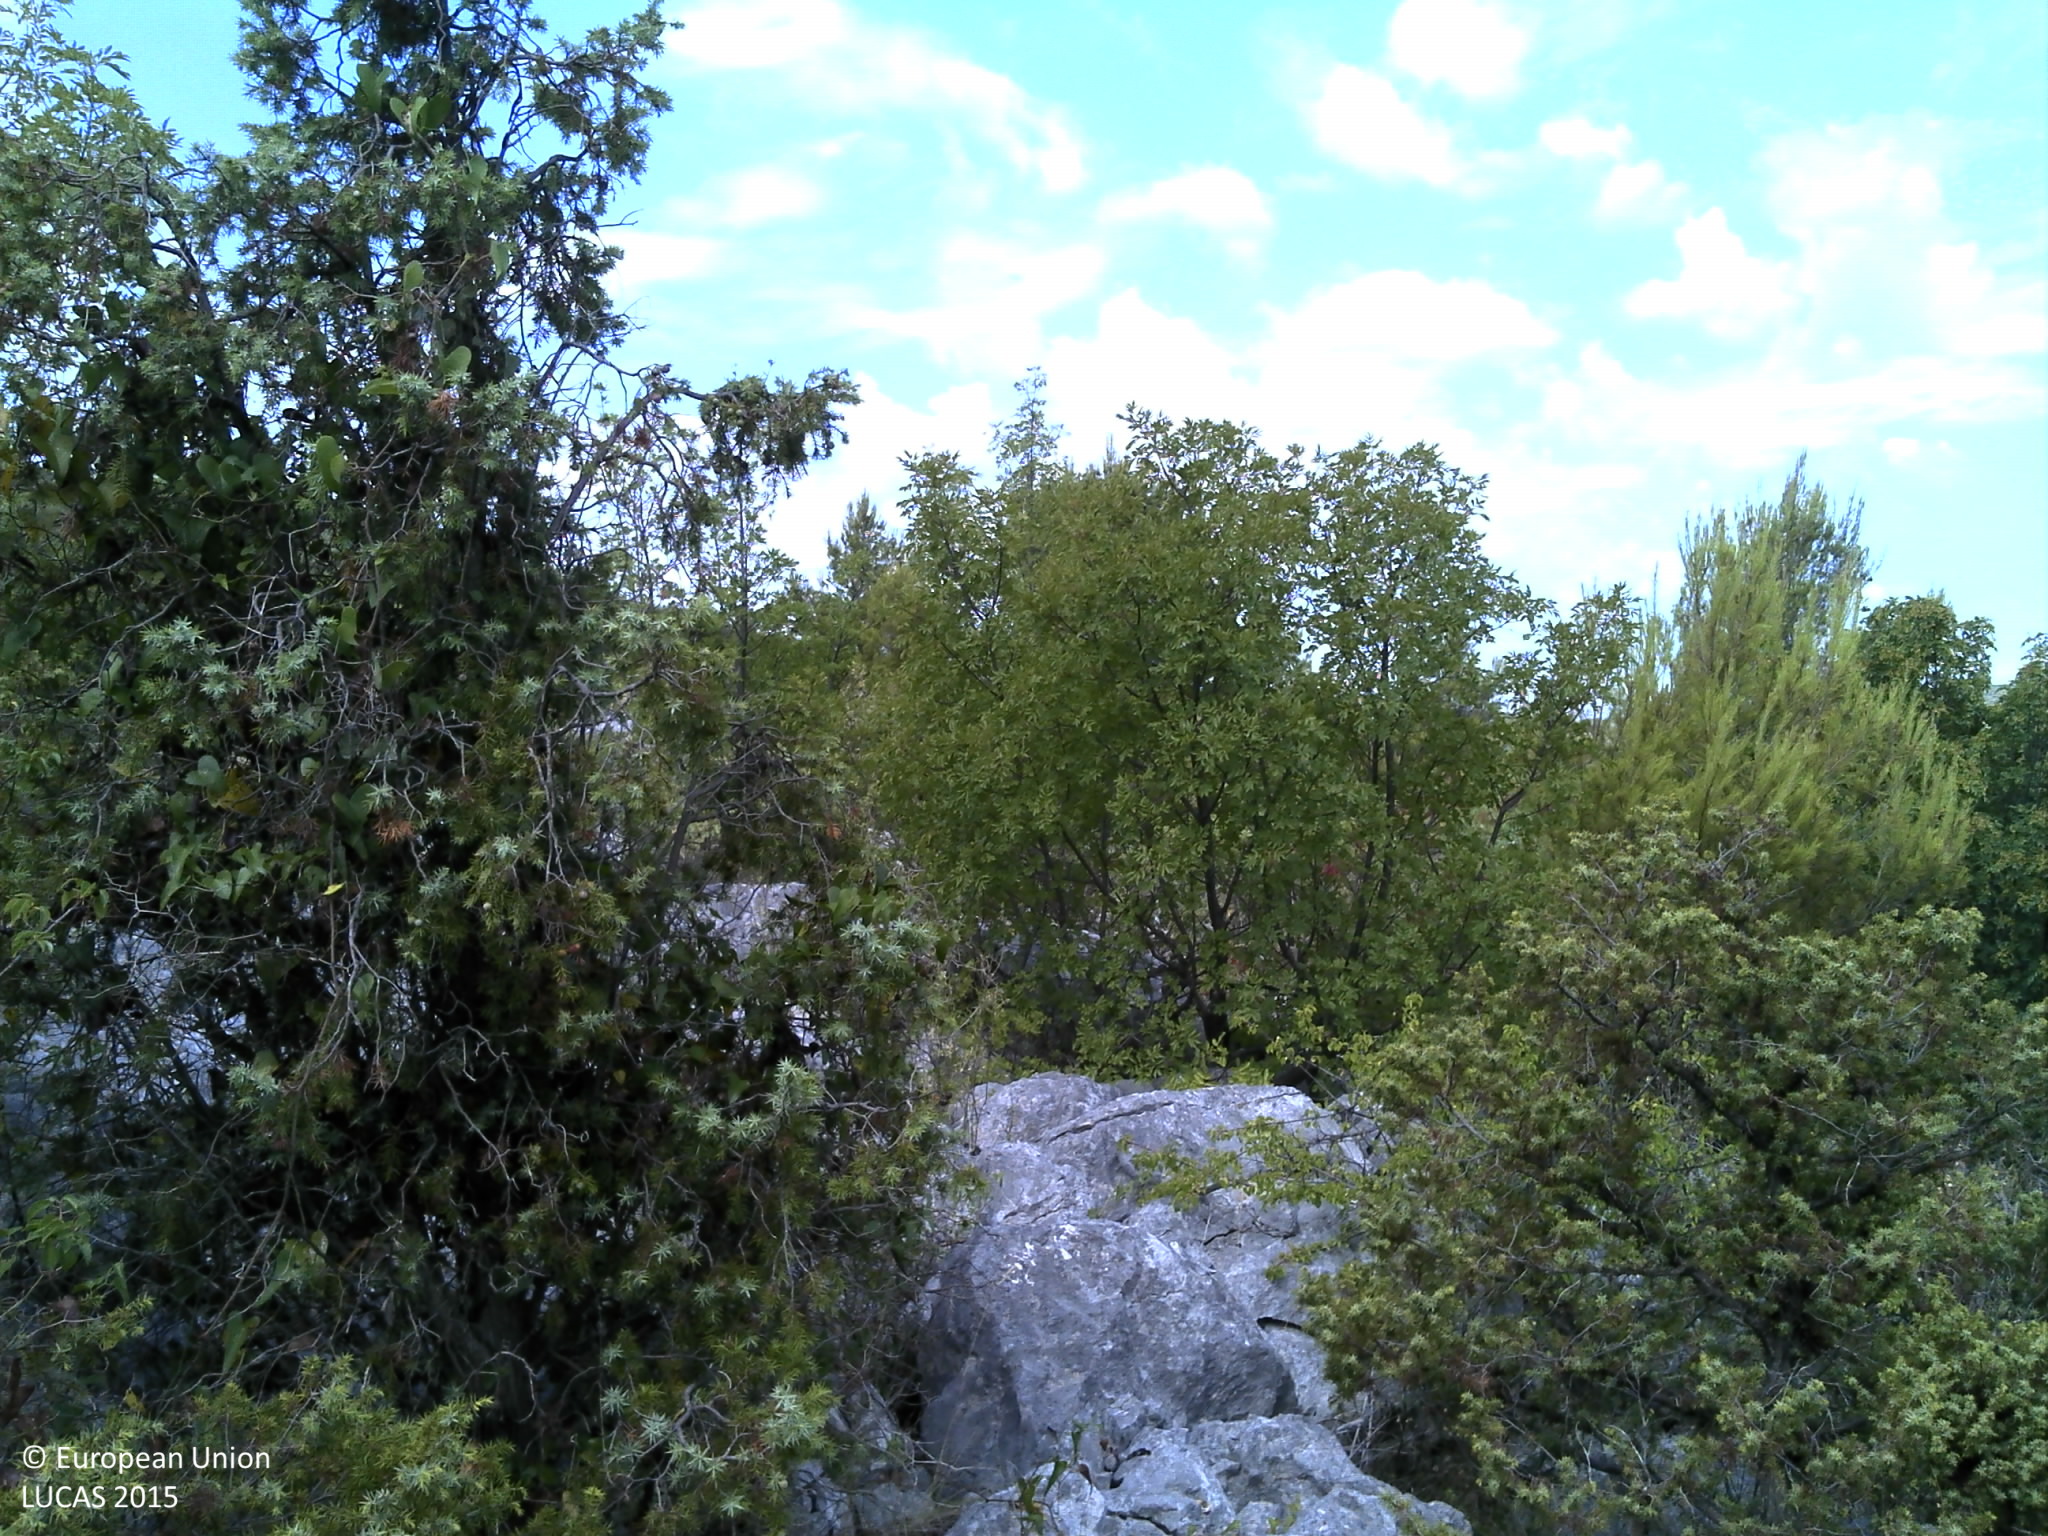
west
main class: Woodland
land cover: Pine dominated coniferous woodland
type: coniferous forest of the mediterranean region
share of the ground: 25 - 50 %
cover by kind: shrubs 40 %, coniferous forest trees 35 %, consolidated bare surface 15 %, broadleaved forest trees 5 %, unconsolidated bare surface 5 %
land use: Semi-natural and natural areas not in use
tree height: > 5 m
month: July
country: HR
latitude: 43.8060
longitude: 15.8460
